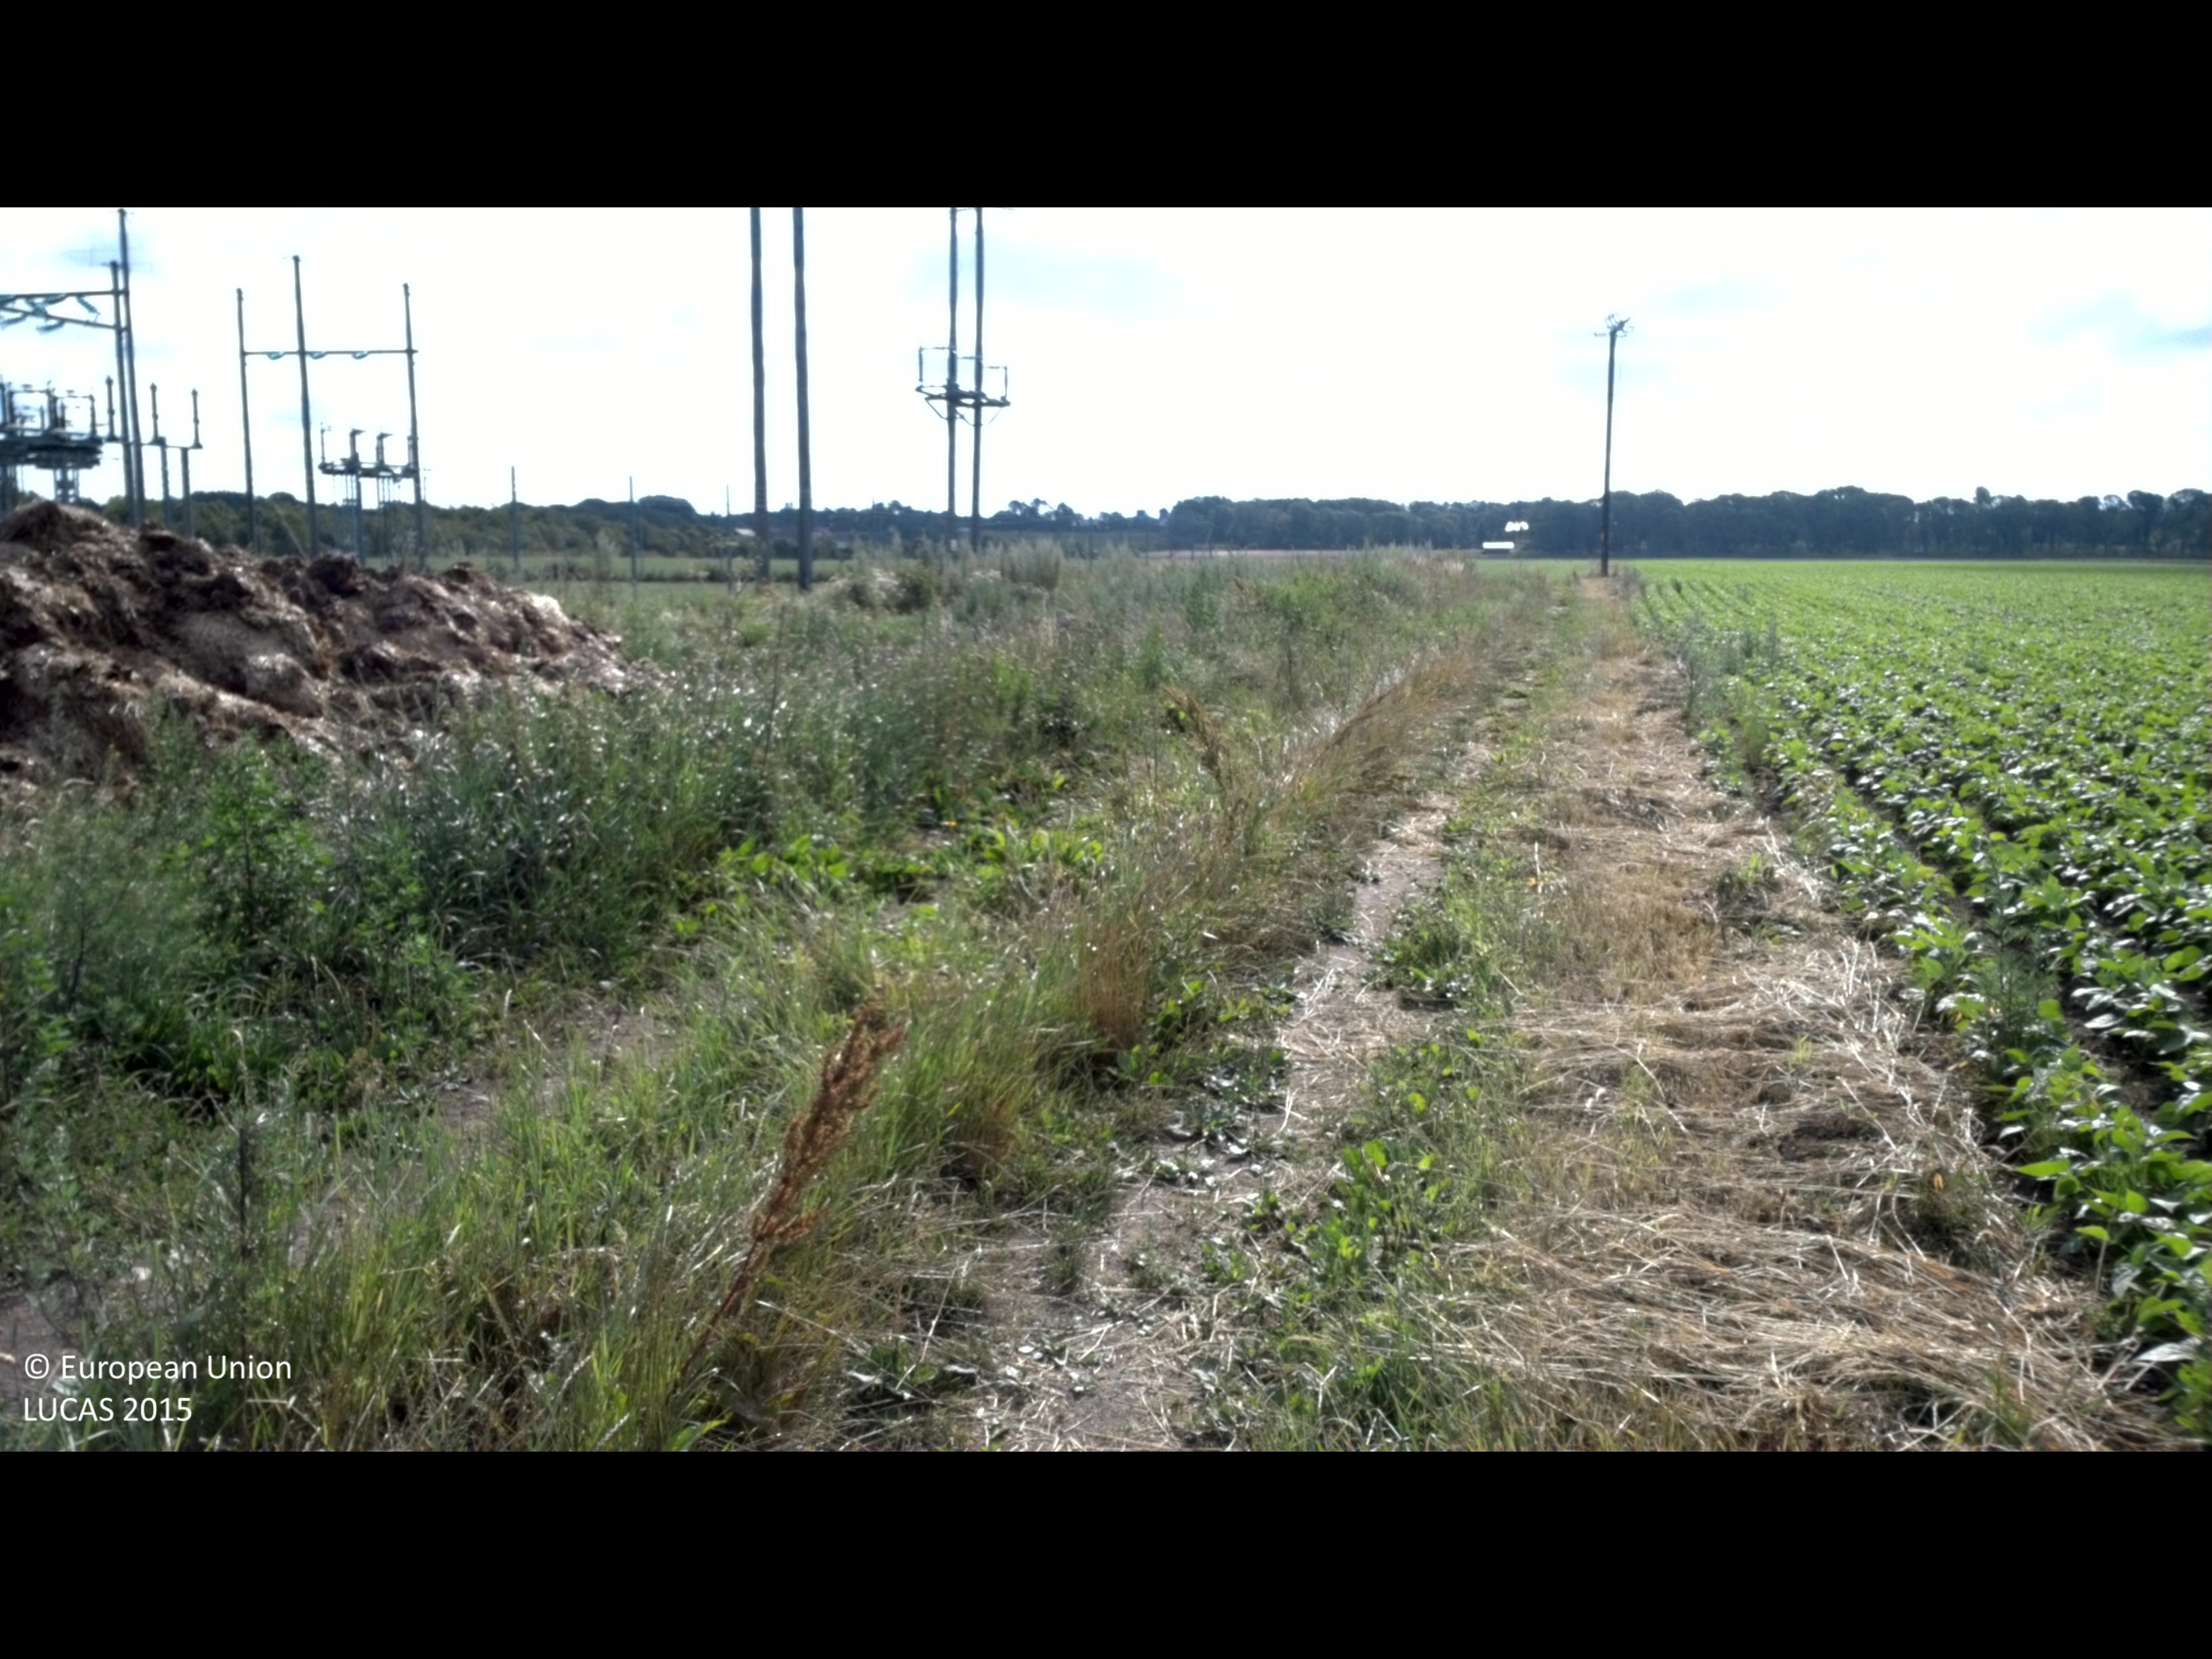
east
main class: Cropland
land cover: Dry pulses
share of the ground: > 75 %
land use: Agriculture (excluding fallow land and kitchen gardens)
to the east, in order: Dry pulses; Electric lines; Dry pulses; Electric lines; Dry pulses; Electric lines; Dry pulses; Temporary grasslands
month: July
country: SE
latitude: 56.5141
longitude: 16.4208
